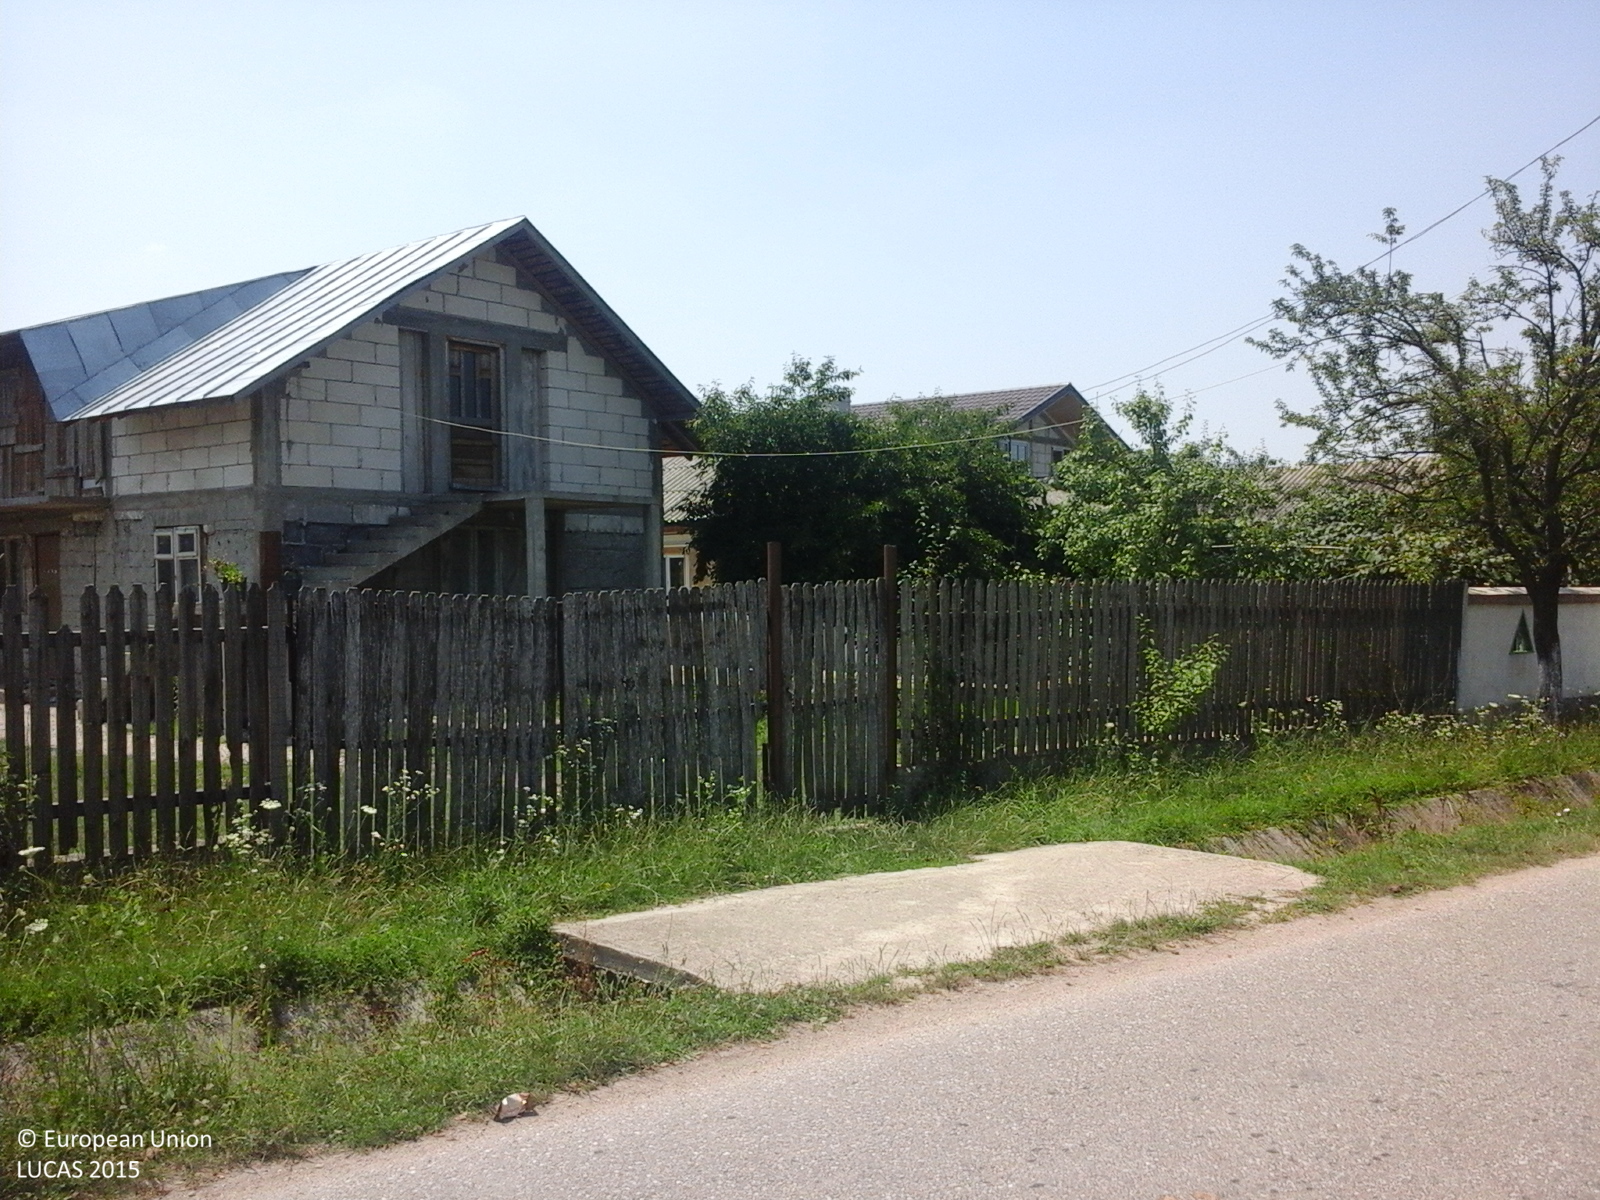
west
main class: Grassland
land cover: Spontaneously vegetated surfaces
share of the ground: > 75 %
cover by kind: herbaceous plants 100 %
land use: Fallow land
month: July
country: RO
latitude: 44.6222
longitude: 25.4039
